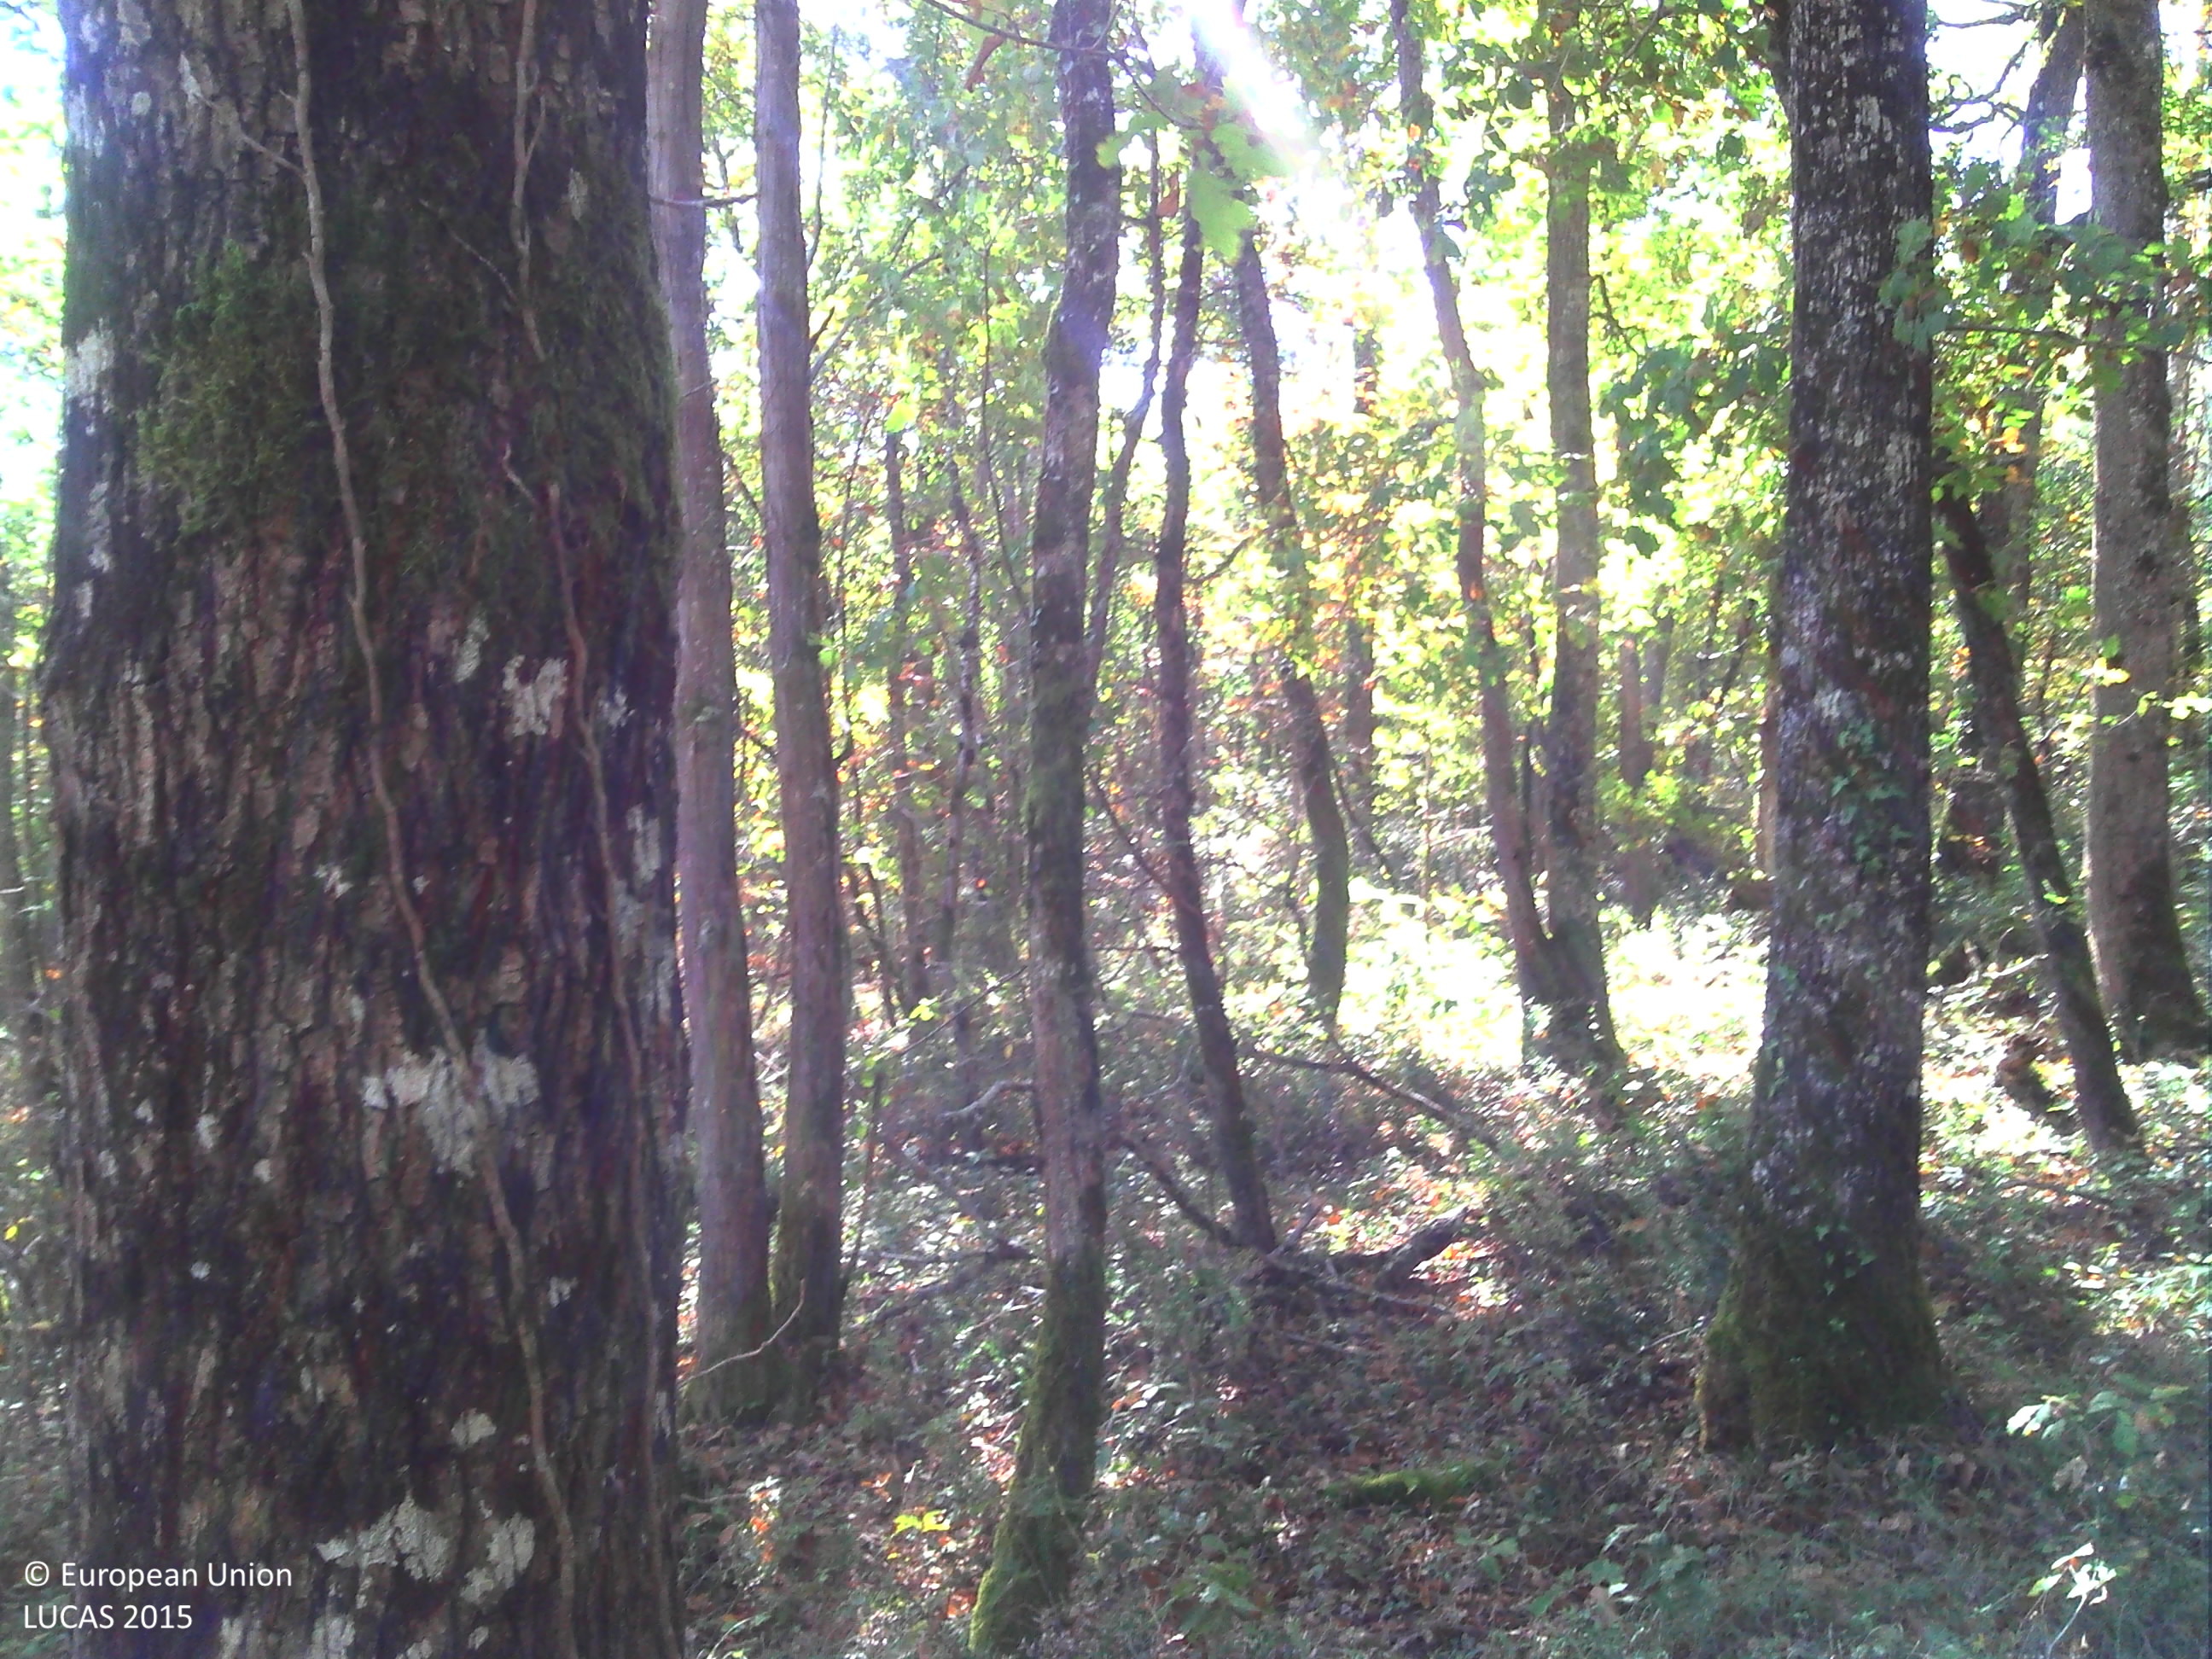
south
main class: Woodland
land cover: Broadleaved woodland
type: mesophytic deciduous forest
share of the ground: > 75 %
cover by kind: broadleaved forest trees 75 %, shrubs 15 %, herbaceous plants 5 %
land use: Forestry
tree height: > 5 m
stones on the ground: < 10 %
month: October
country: FR
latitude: 44.0206
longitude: 0.8779
